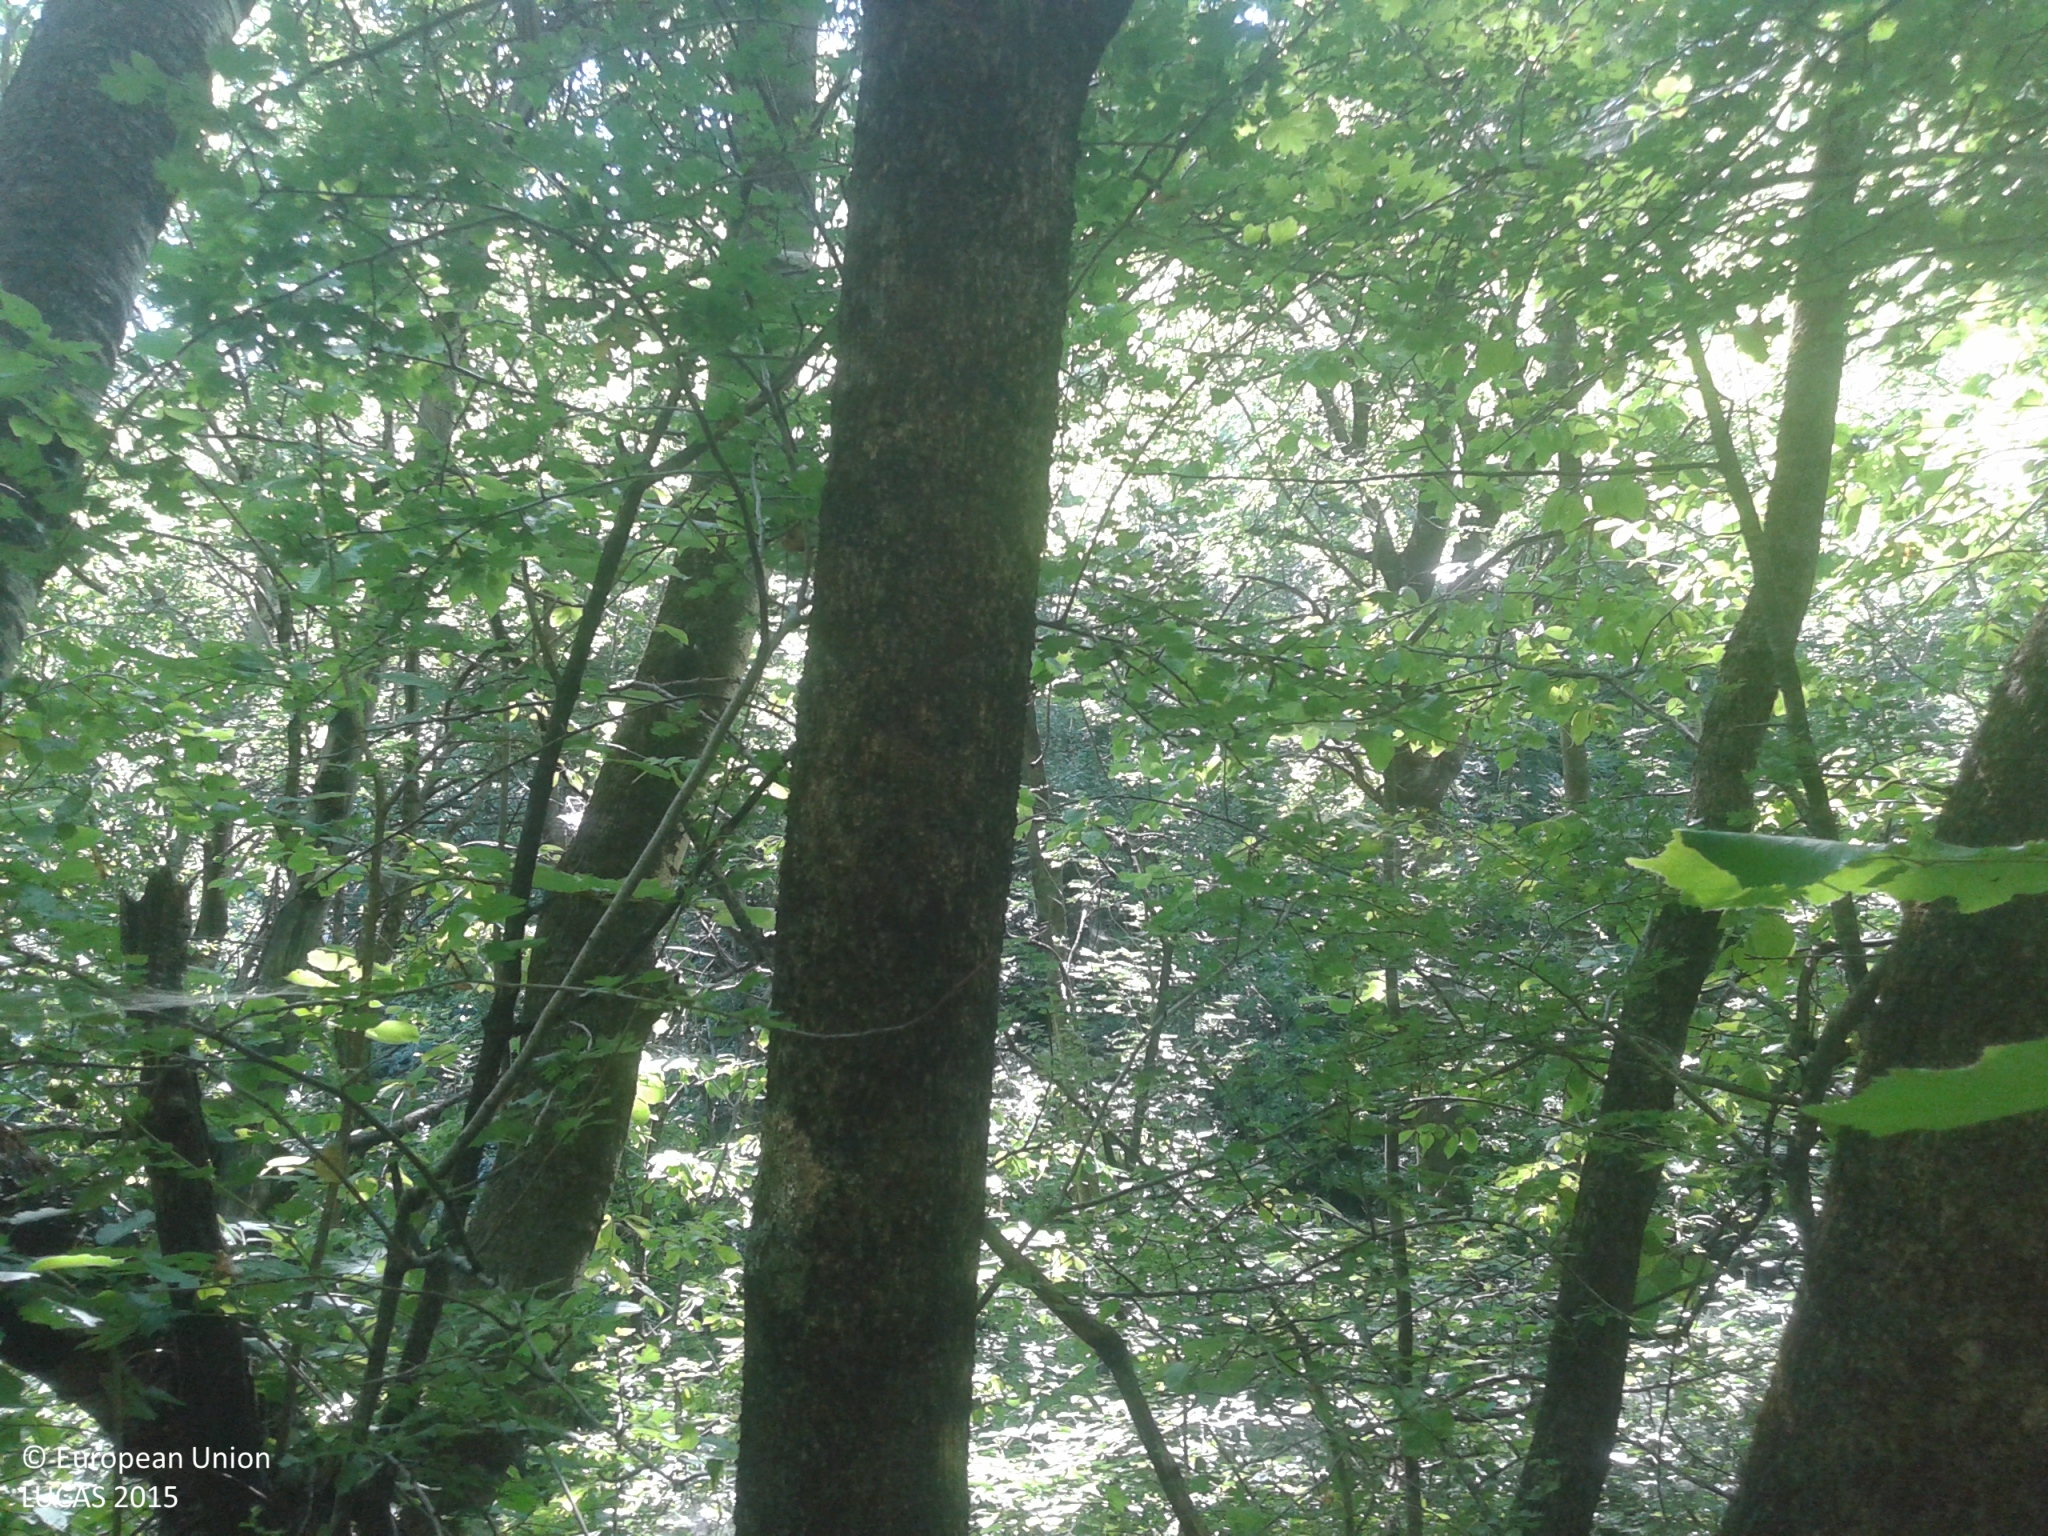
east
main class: Woodland
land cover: Broadleaved woodland
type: alpine coniferous forest
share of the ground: > 75 %
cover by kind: broadleaved forest trees 95 %, herbaceous plants 5 %
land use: Semi-natural and natural areas not in use
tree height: > 5 m
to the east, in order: Broadleaved woodland; Rivers and streams; Broadleaved woodland; Fences; Grassland with sparse tree/shrub cover; Broadleaved woodland; Grassland with sparse tree/shrub cover; Broadleaved woodland; Dry stone walls; Broadleaved woodland; Grassland with sparse tree/shrub cover; Dry stone walls; Broadleaved woodland; Shrubland with sparse tree cover; Broadleaved woodland
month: July
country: ES
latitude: 42.4407
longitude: 1.0725
